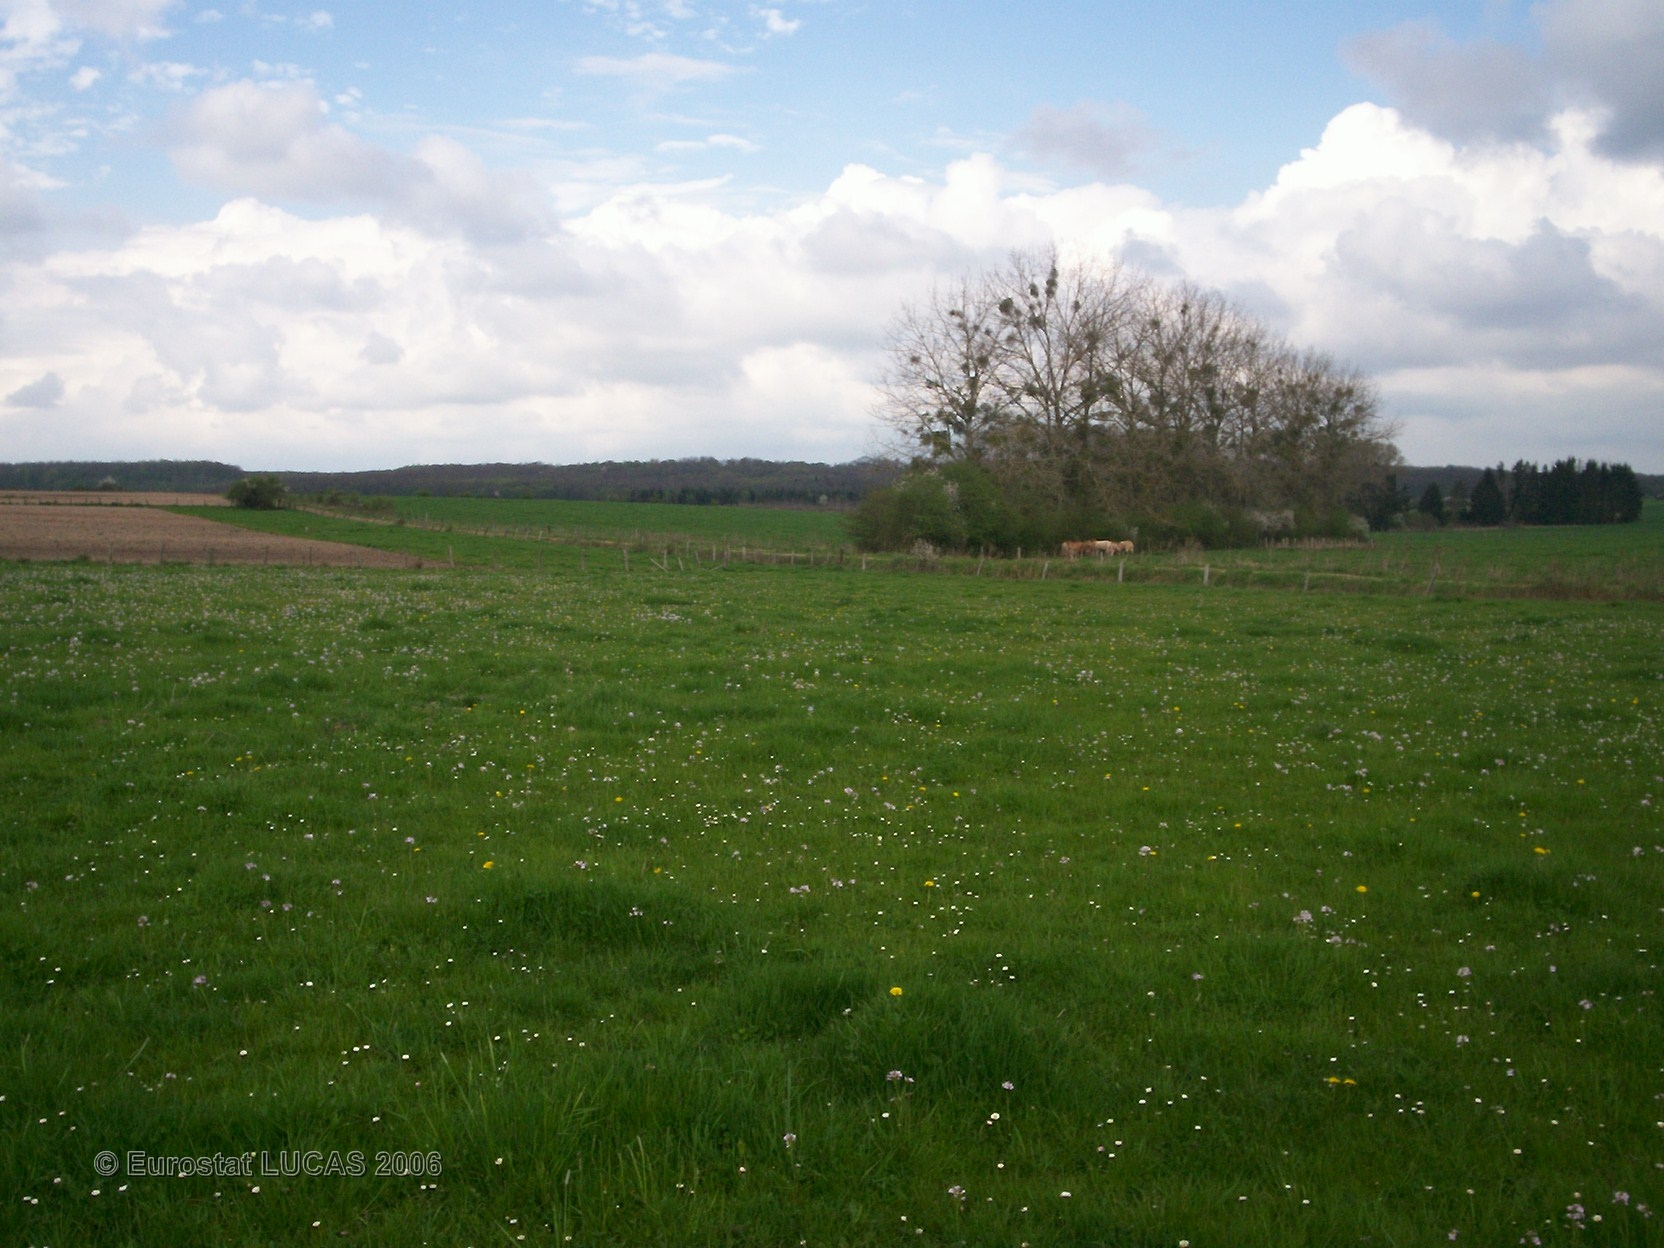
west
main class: Grassland
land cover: Grassland without tree/shrub cover
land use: Agriculture (excluding fallow land and kitchen gardens)
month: April
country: FR
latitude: 48.7535
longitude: 6.8041
